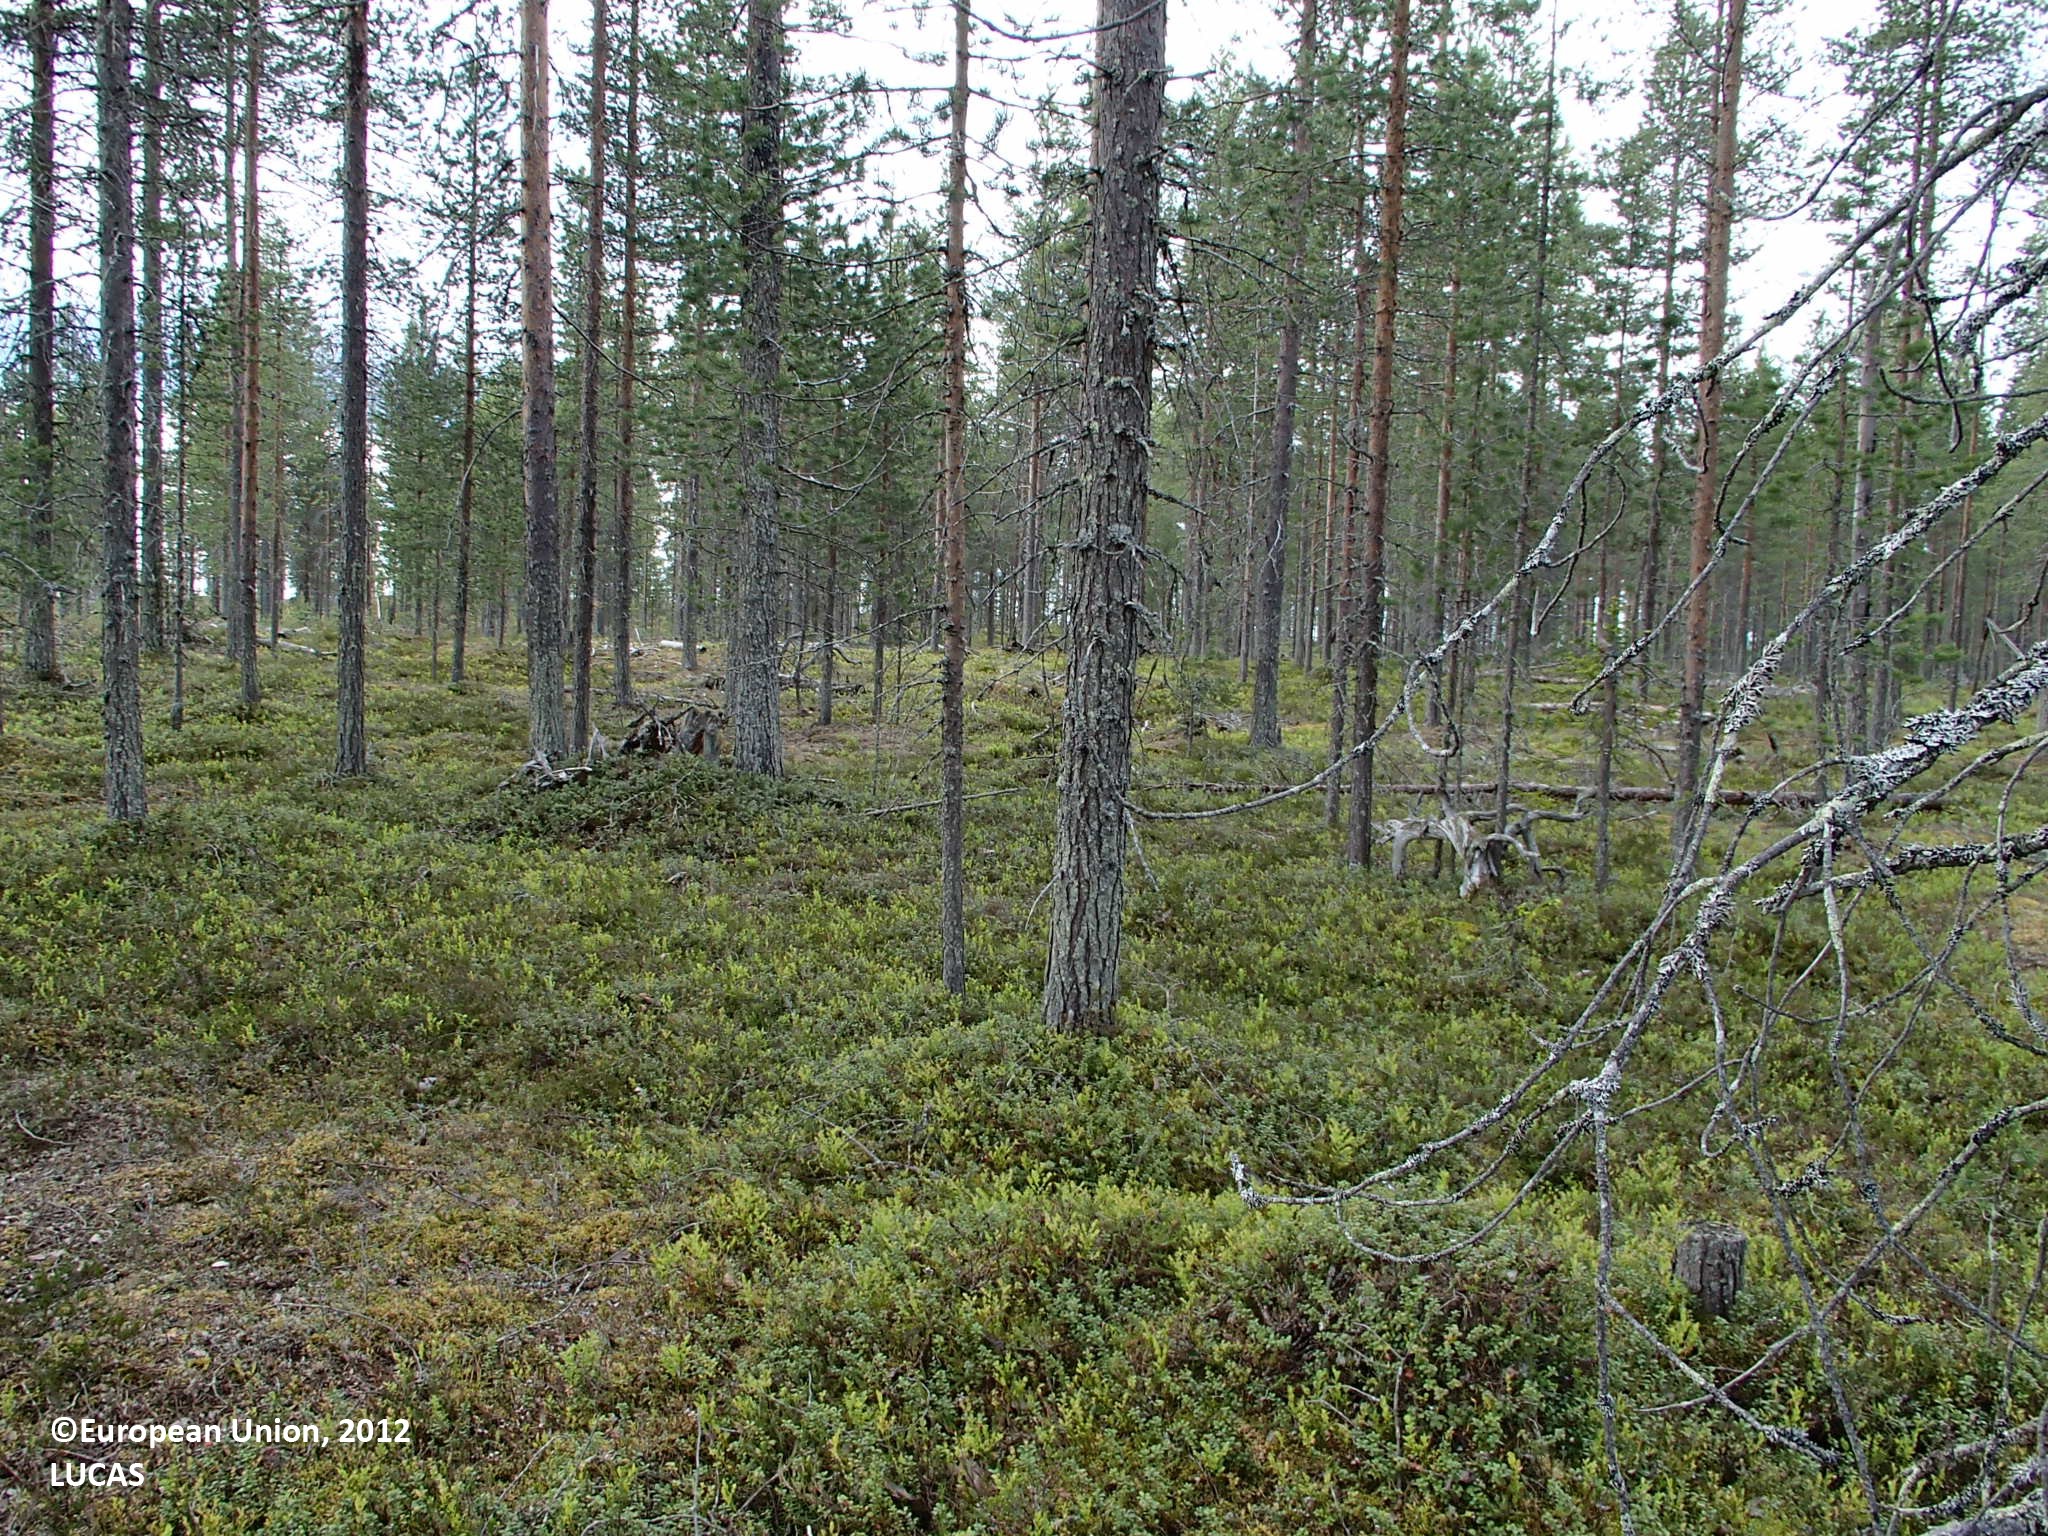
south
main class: Woodland
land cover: Pine dominated coniferous woodland
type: boreal forest
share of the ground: > 75 %
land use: Forestry
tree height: > 5 m
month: June
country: FI
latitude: 66.4565
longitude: 27.0863
